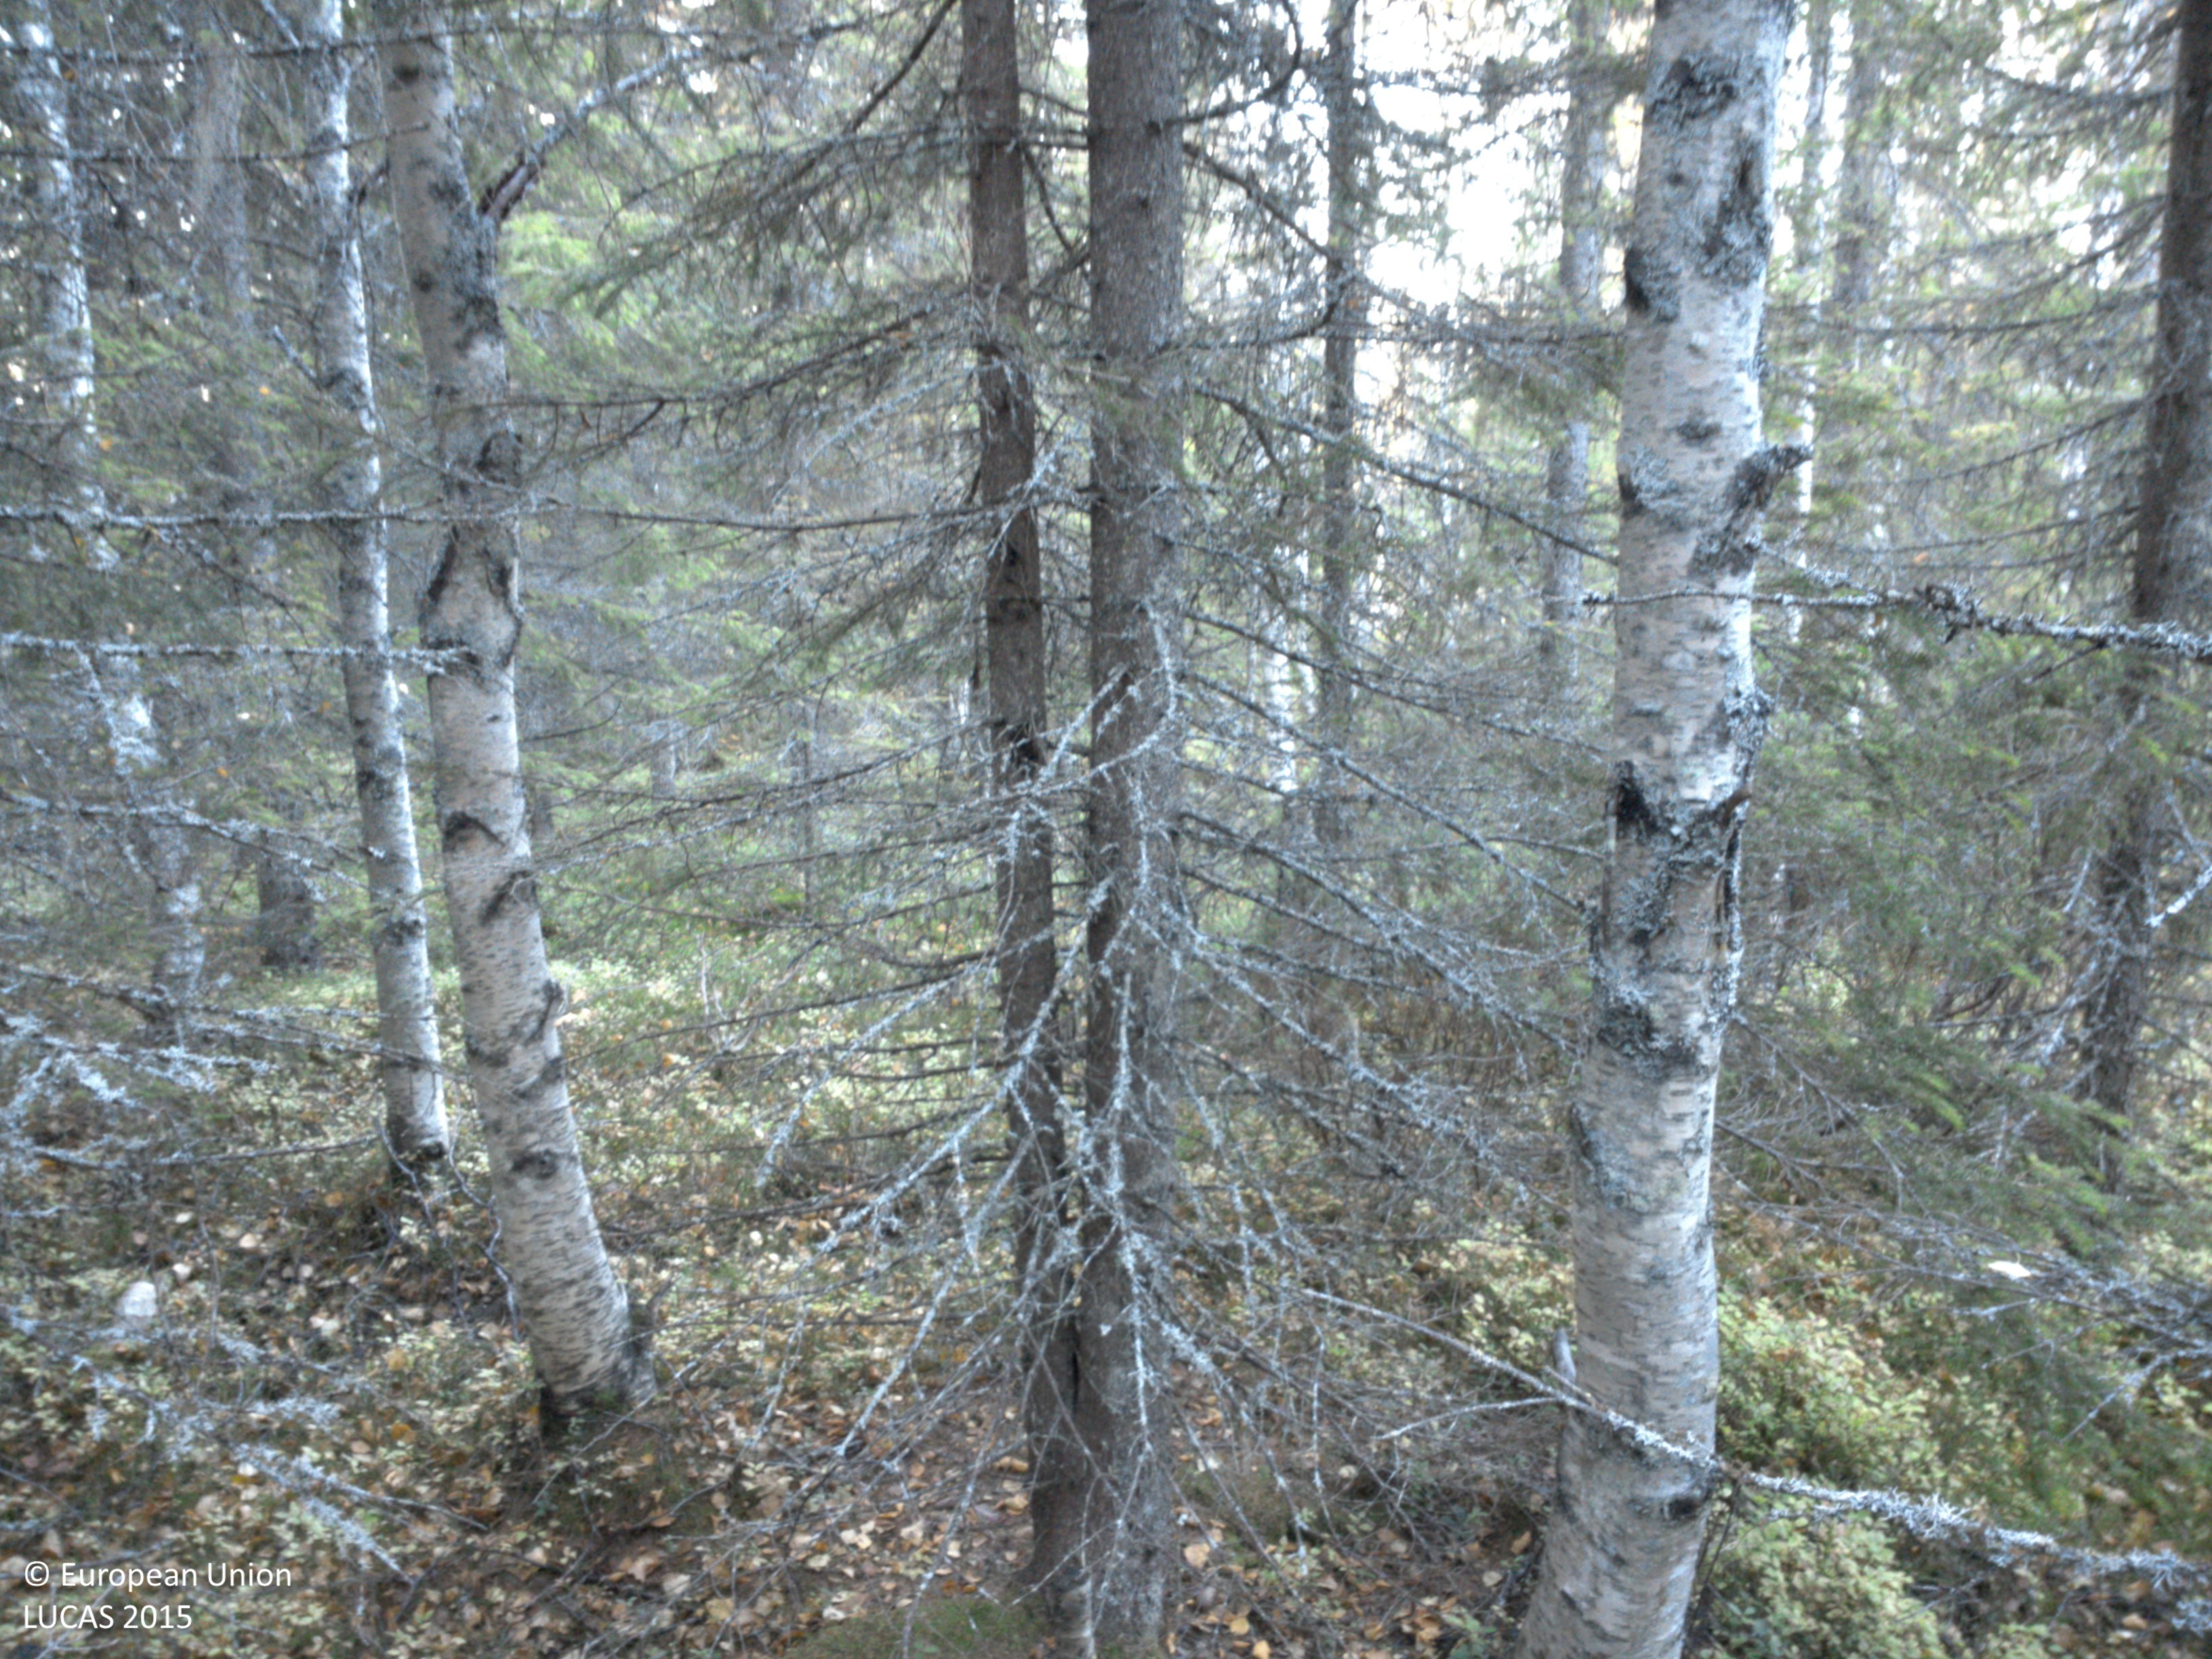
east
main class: Woodland
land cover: Spruce dominated mixed woodland
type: boreal forest
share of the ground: 50 - 75 %
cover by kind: coniferous forest trees 45 %, shrubs 30 %, broadleaved forest trees 15 %, herbaceous plants 10 %
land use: Forestry
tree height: > 5 m
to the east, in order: Spruce dominated mixed woodland; Ditches and canals; Paved roads, cycling and walking lanes; Shruby margins; Spruce dominated coniferous woodland; Spruce dominated mixed woodland
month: October
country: SE
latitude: 64.6594
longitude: 17.8188
